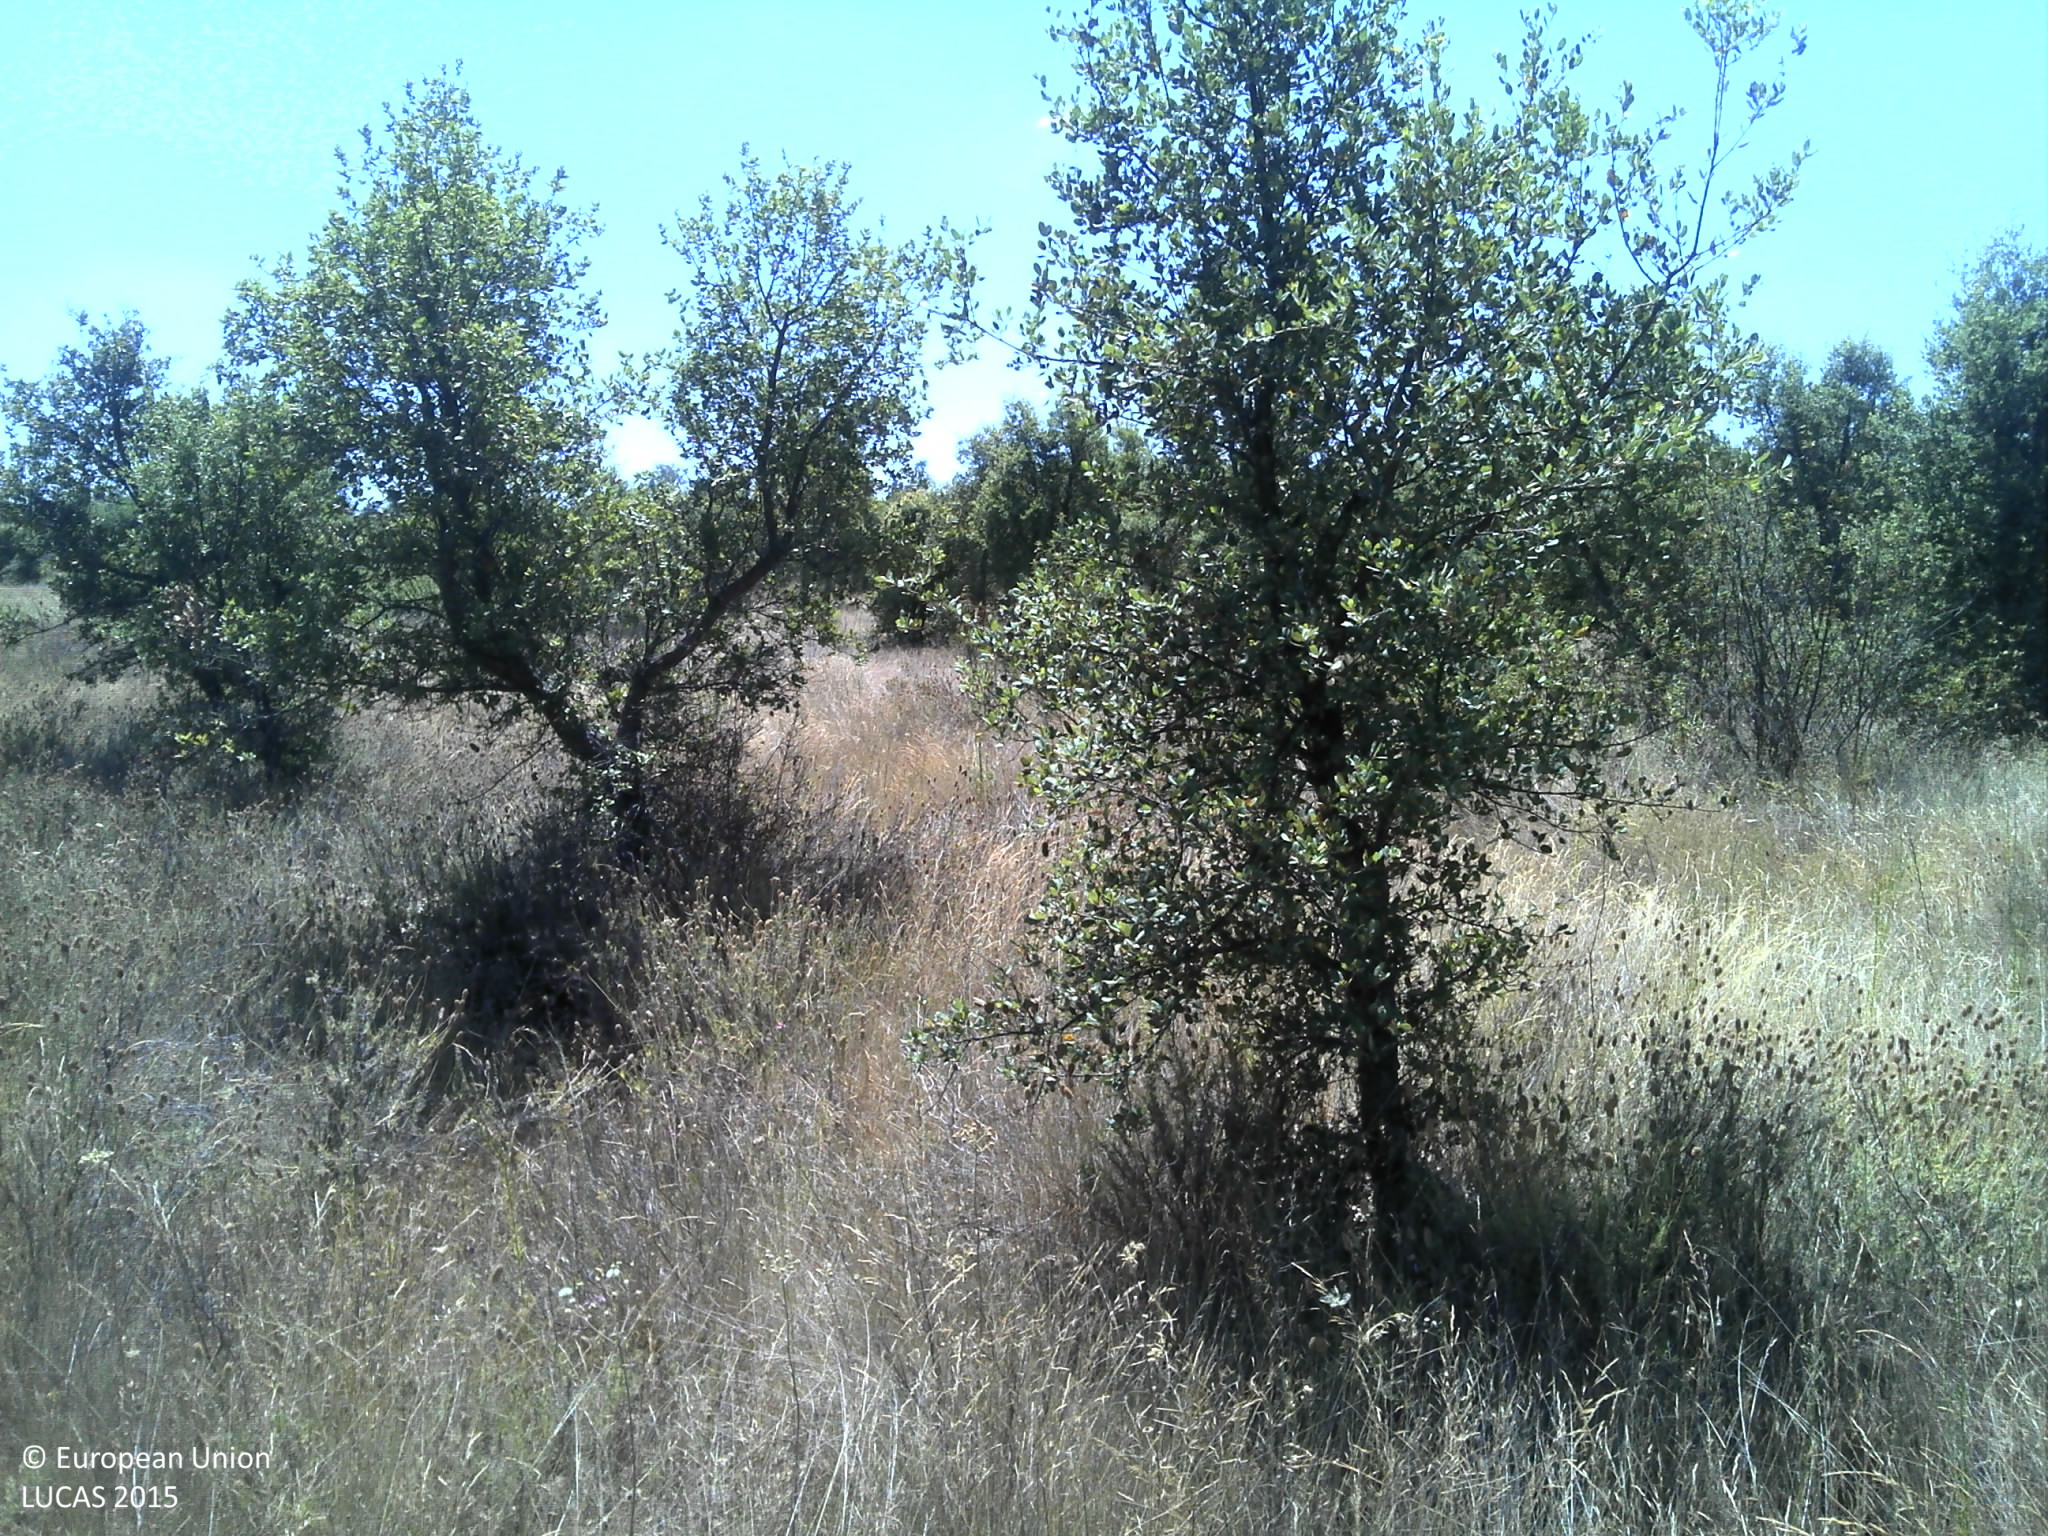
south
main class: Woodland
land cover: Broadleaved woodland
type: broadleaved evergreen forest
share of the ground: 25 - 50 %
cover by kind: broadleaved forest trees 45 %, herbaceous plants 20 %, unconsolidated bare surface 20 %, shrubs 15 %
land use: Forestry
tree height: < 5 m
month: June
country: PT
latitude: 40.0903
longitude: -7.2572
